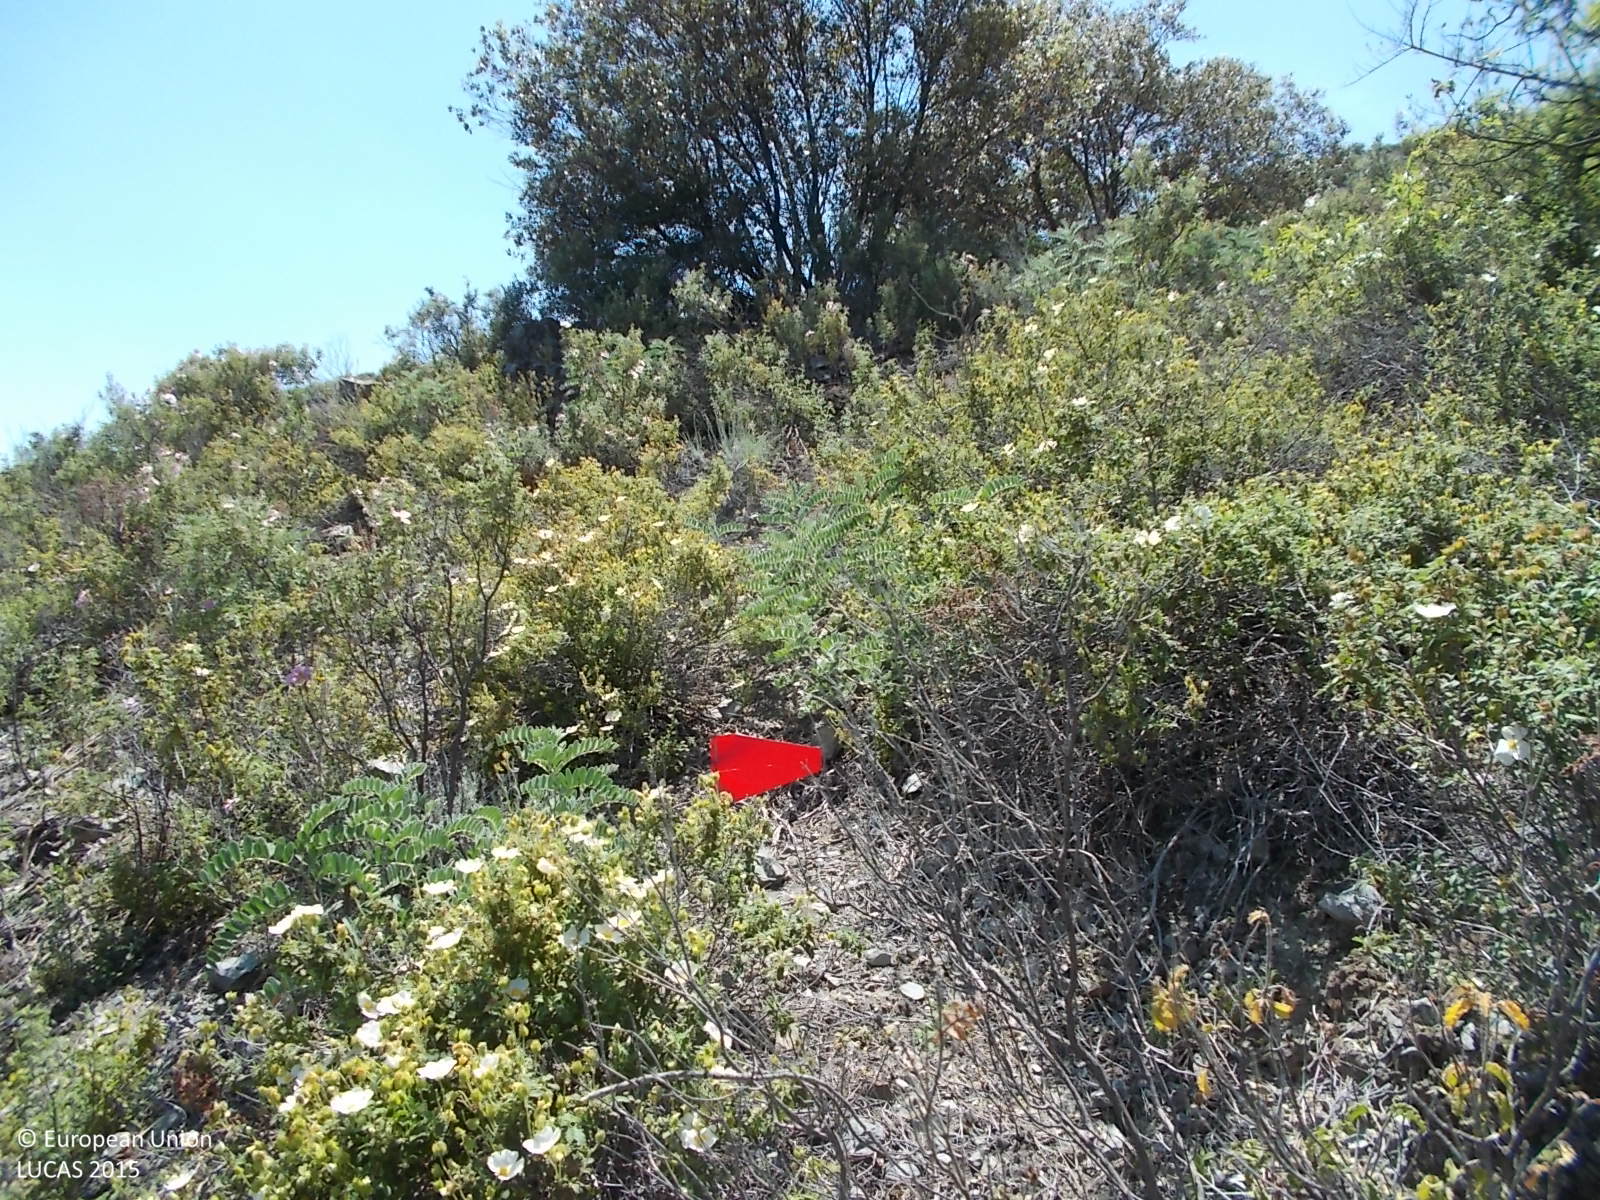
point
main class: Shrubland
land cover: Shrubland with sparse tree cover
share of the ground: 50 - 75 %
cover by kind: shrubs 75 %, unconsolidated bare surface 15 %, broadleaved forest trees 5 %, consolidated bare surface 5 %
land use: Forestry
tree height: > 5 m
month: May
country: CY
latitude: 34.8582
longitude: 33.0419
